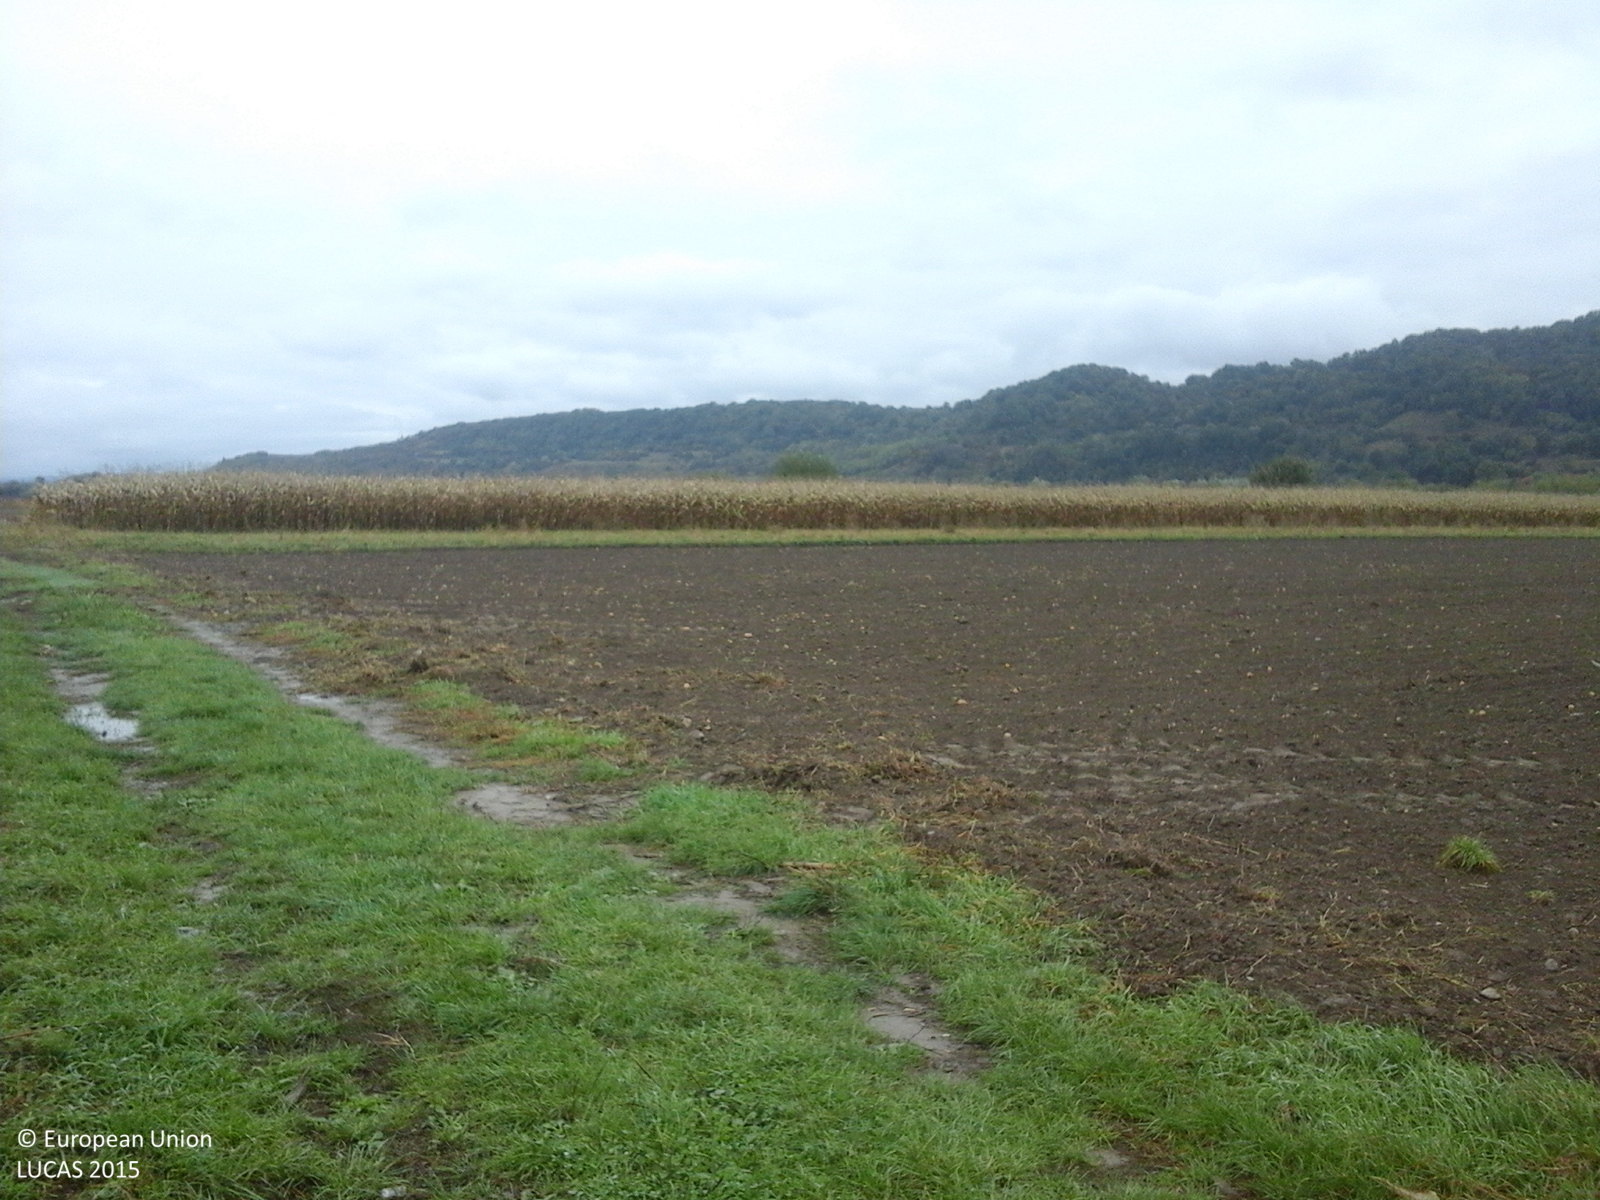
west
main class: Cropland
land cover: Maize
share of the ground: > 75 %
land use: Agriculture (excluding fallow land and kitchen gardens)
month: October
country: RO
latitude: 45.7882
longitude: 24.5541
